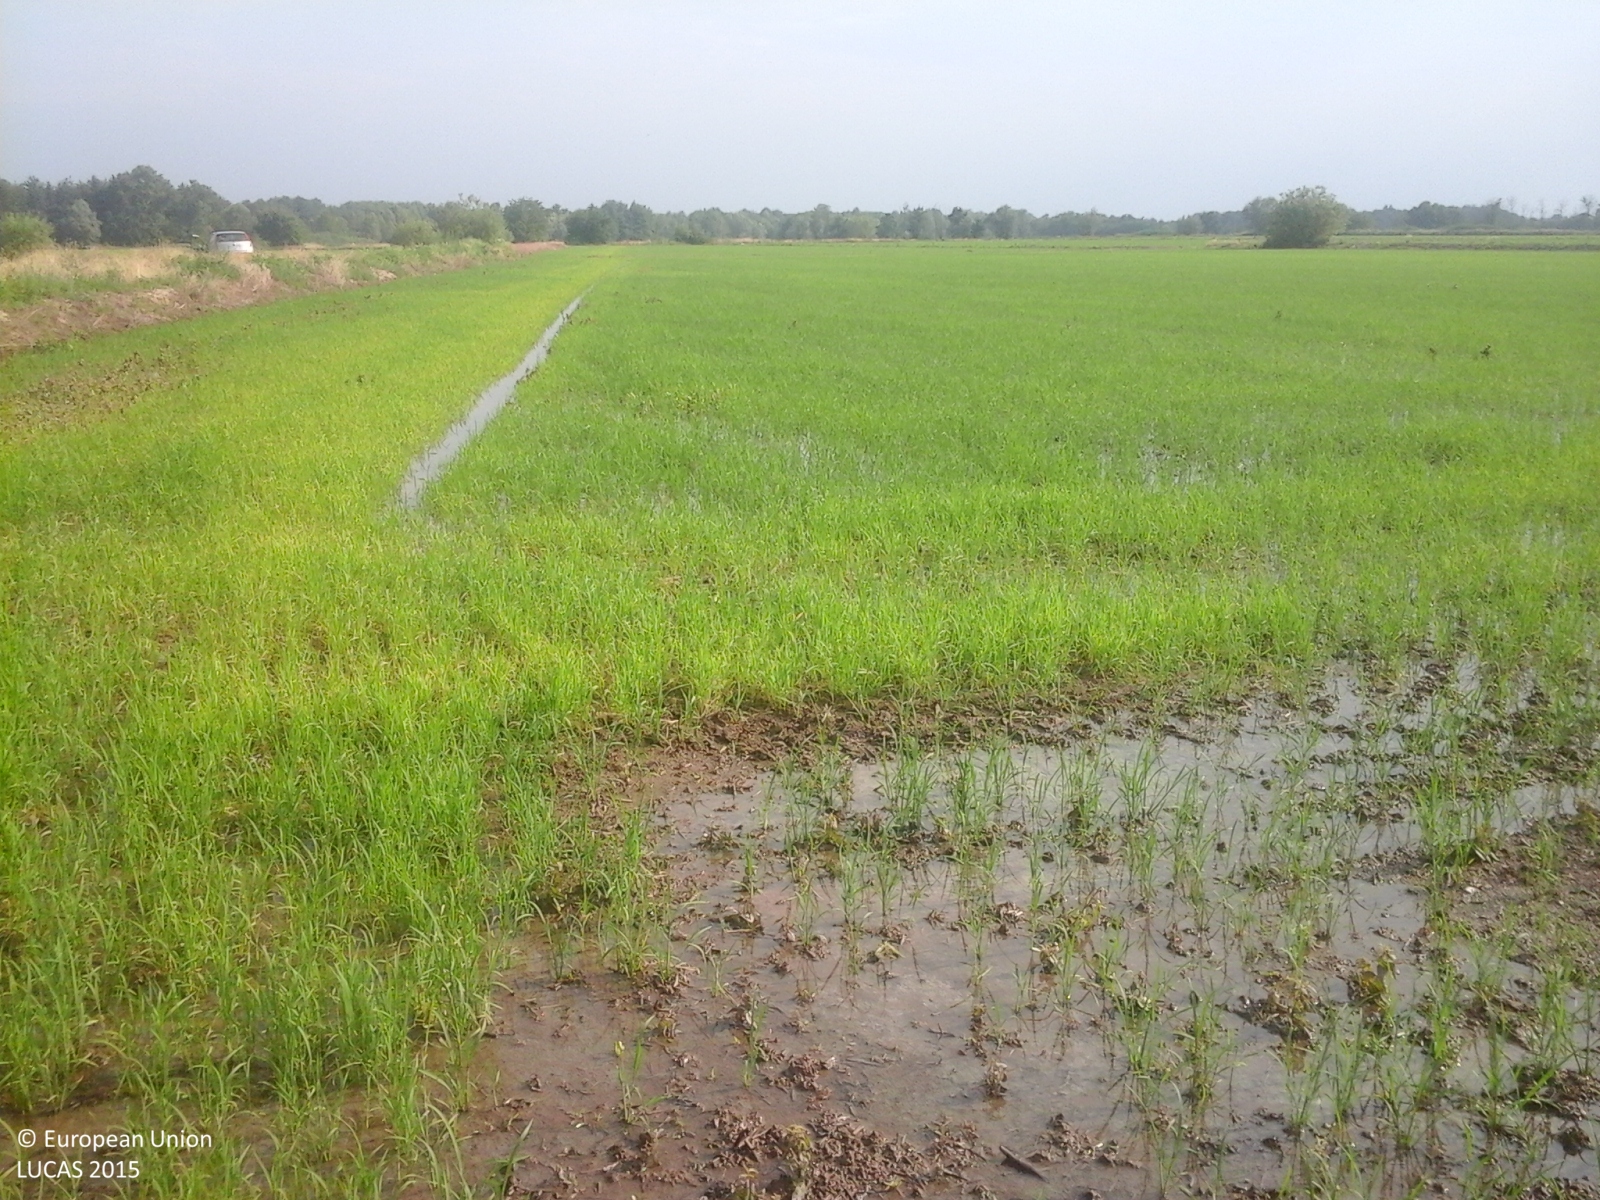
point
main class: Cropland
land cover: Rice
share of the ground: 50 - 75 %
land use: Agriculture (excluding fallow land and kitchen gardens)
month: June
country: IT
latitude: 45.4907
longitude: 8.3010
